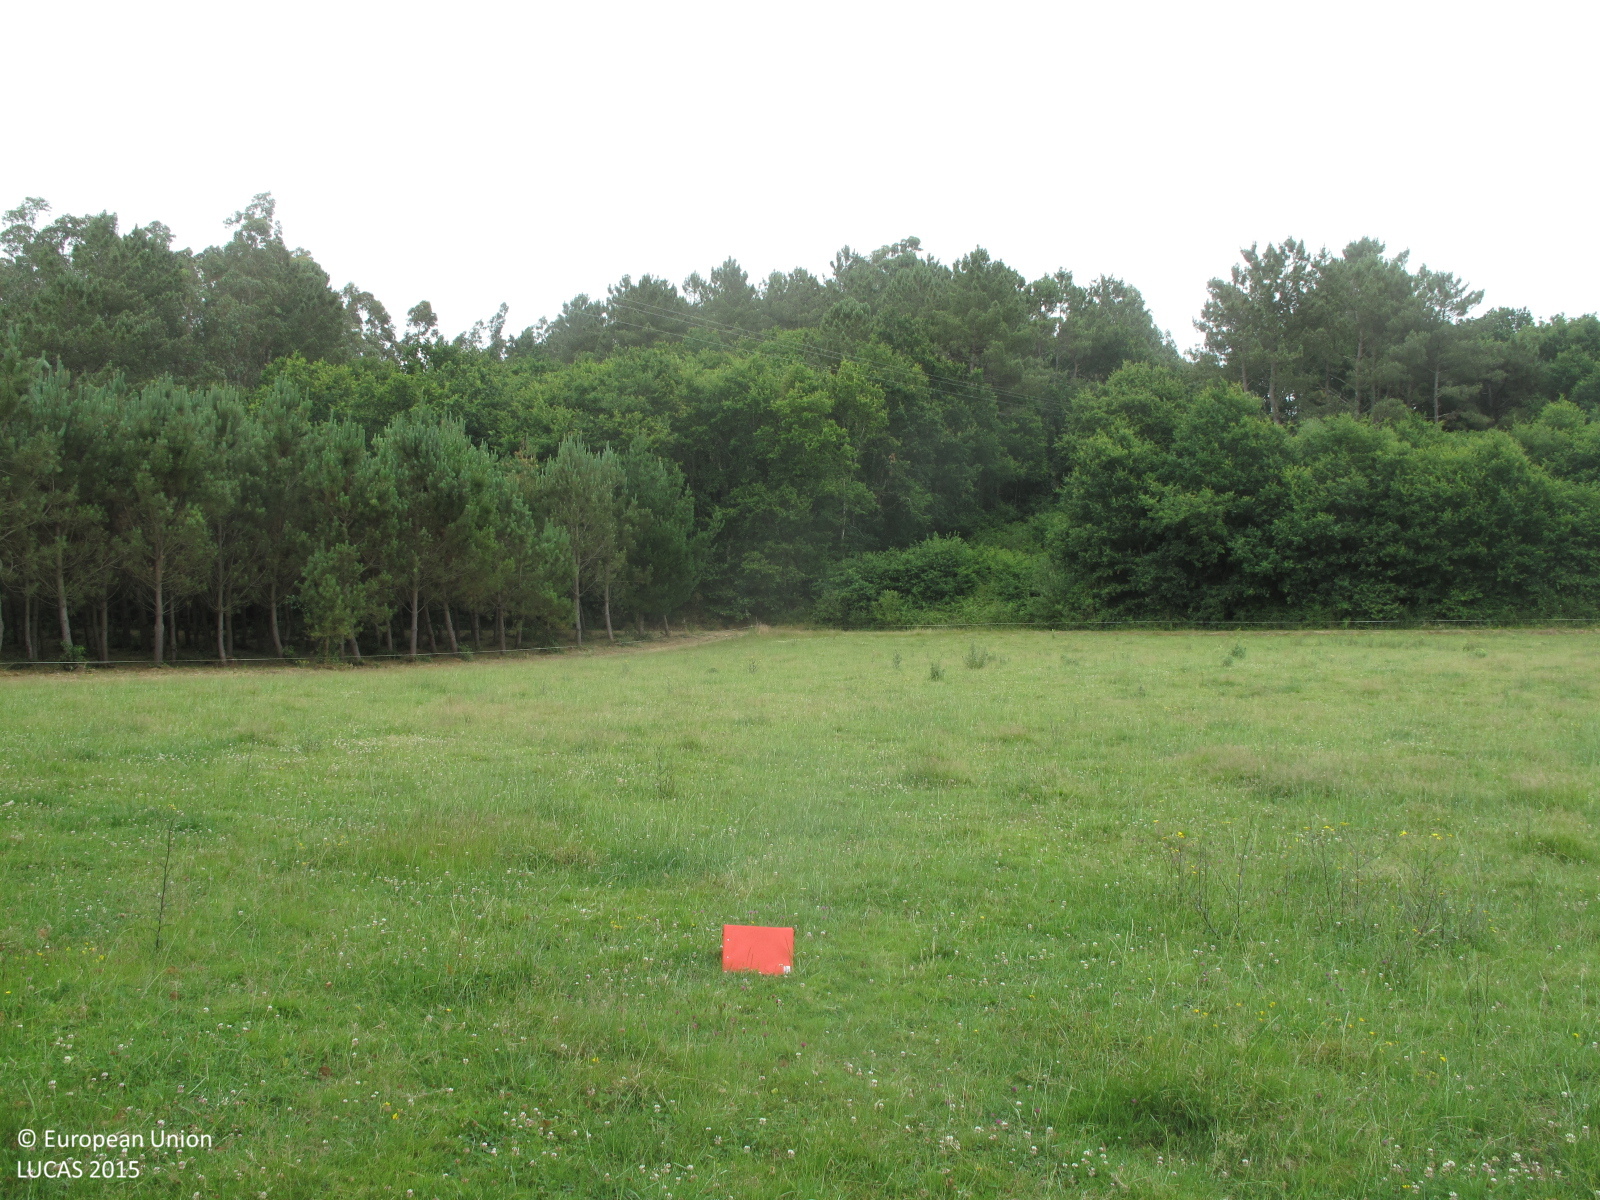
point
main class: Grassland
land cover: Grassland without tree/shrub cover
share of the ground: > 75 %
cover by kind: herbaceous plants 100 %
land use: Agriculture (excluding fallow land and kitchen gardens)
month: July
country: ES
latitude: 43.2341
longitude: -8.2379
